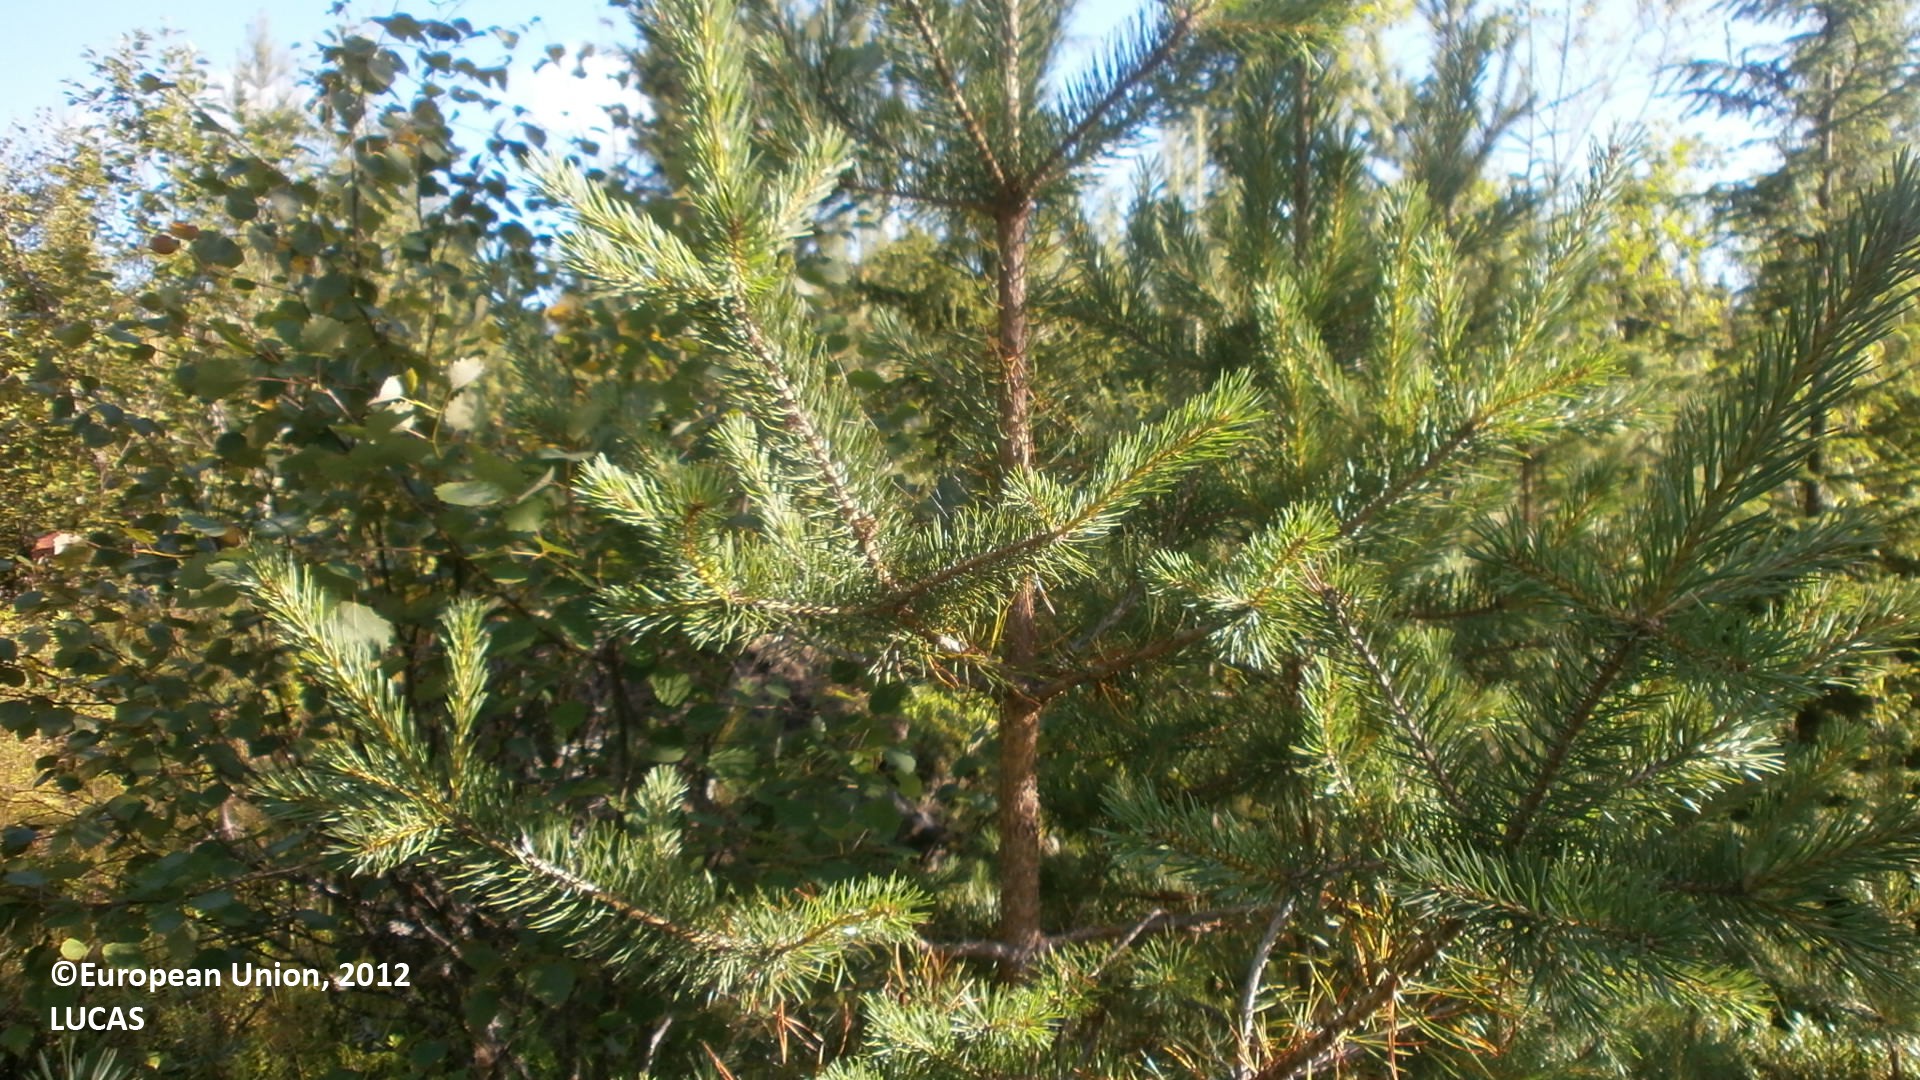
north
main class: Woodland
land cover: Pine dominated mixed woodland
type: boreal forest
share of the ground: 50 - 75 %
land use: Forestry
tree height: > 5 m
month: July
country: FI
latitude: 64.0764
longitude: 24.1103
